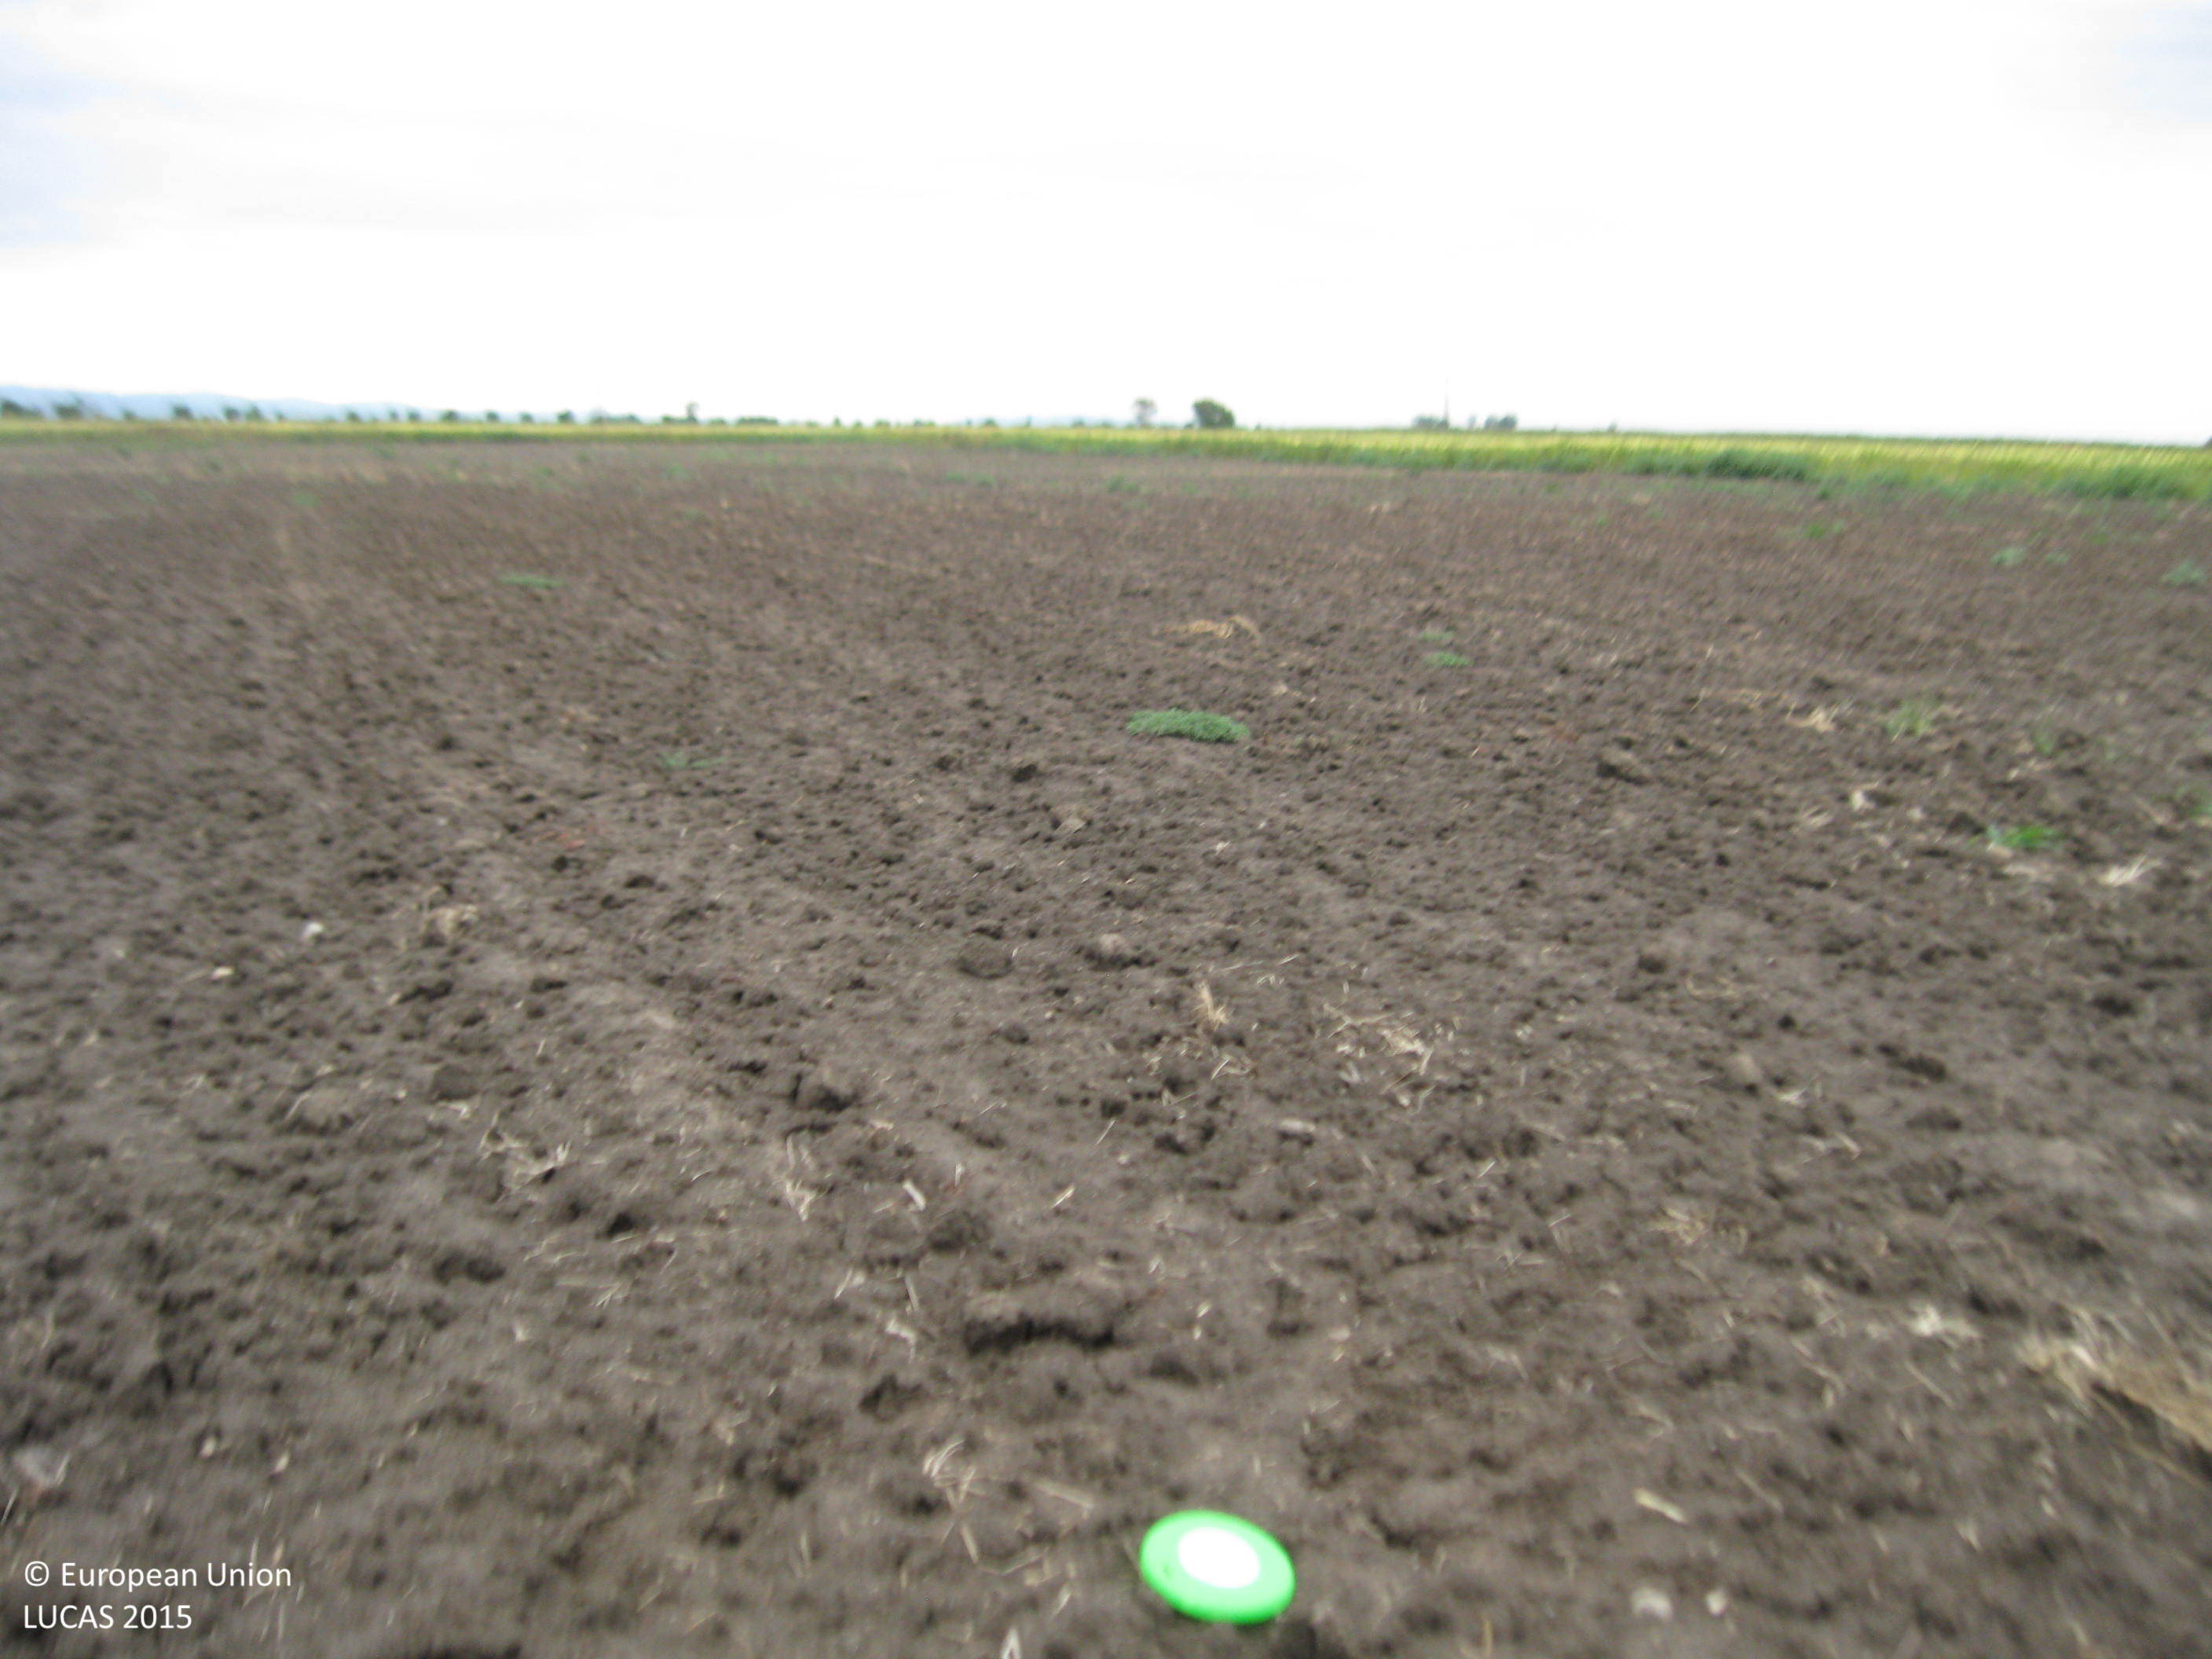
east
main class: Cropland
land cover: Common wheat
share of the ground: < 10 %
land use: Agriculture (excluding fallow land and kitchen gardens)
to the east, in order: Common wheat; Grass margins; Sunflower
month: August
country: BG
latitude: 42.2096
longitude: 24.7447
